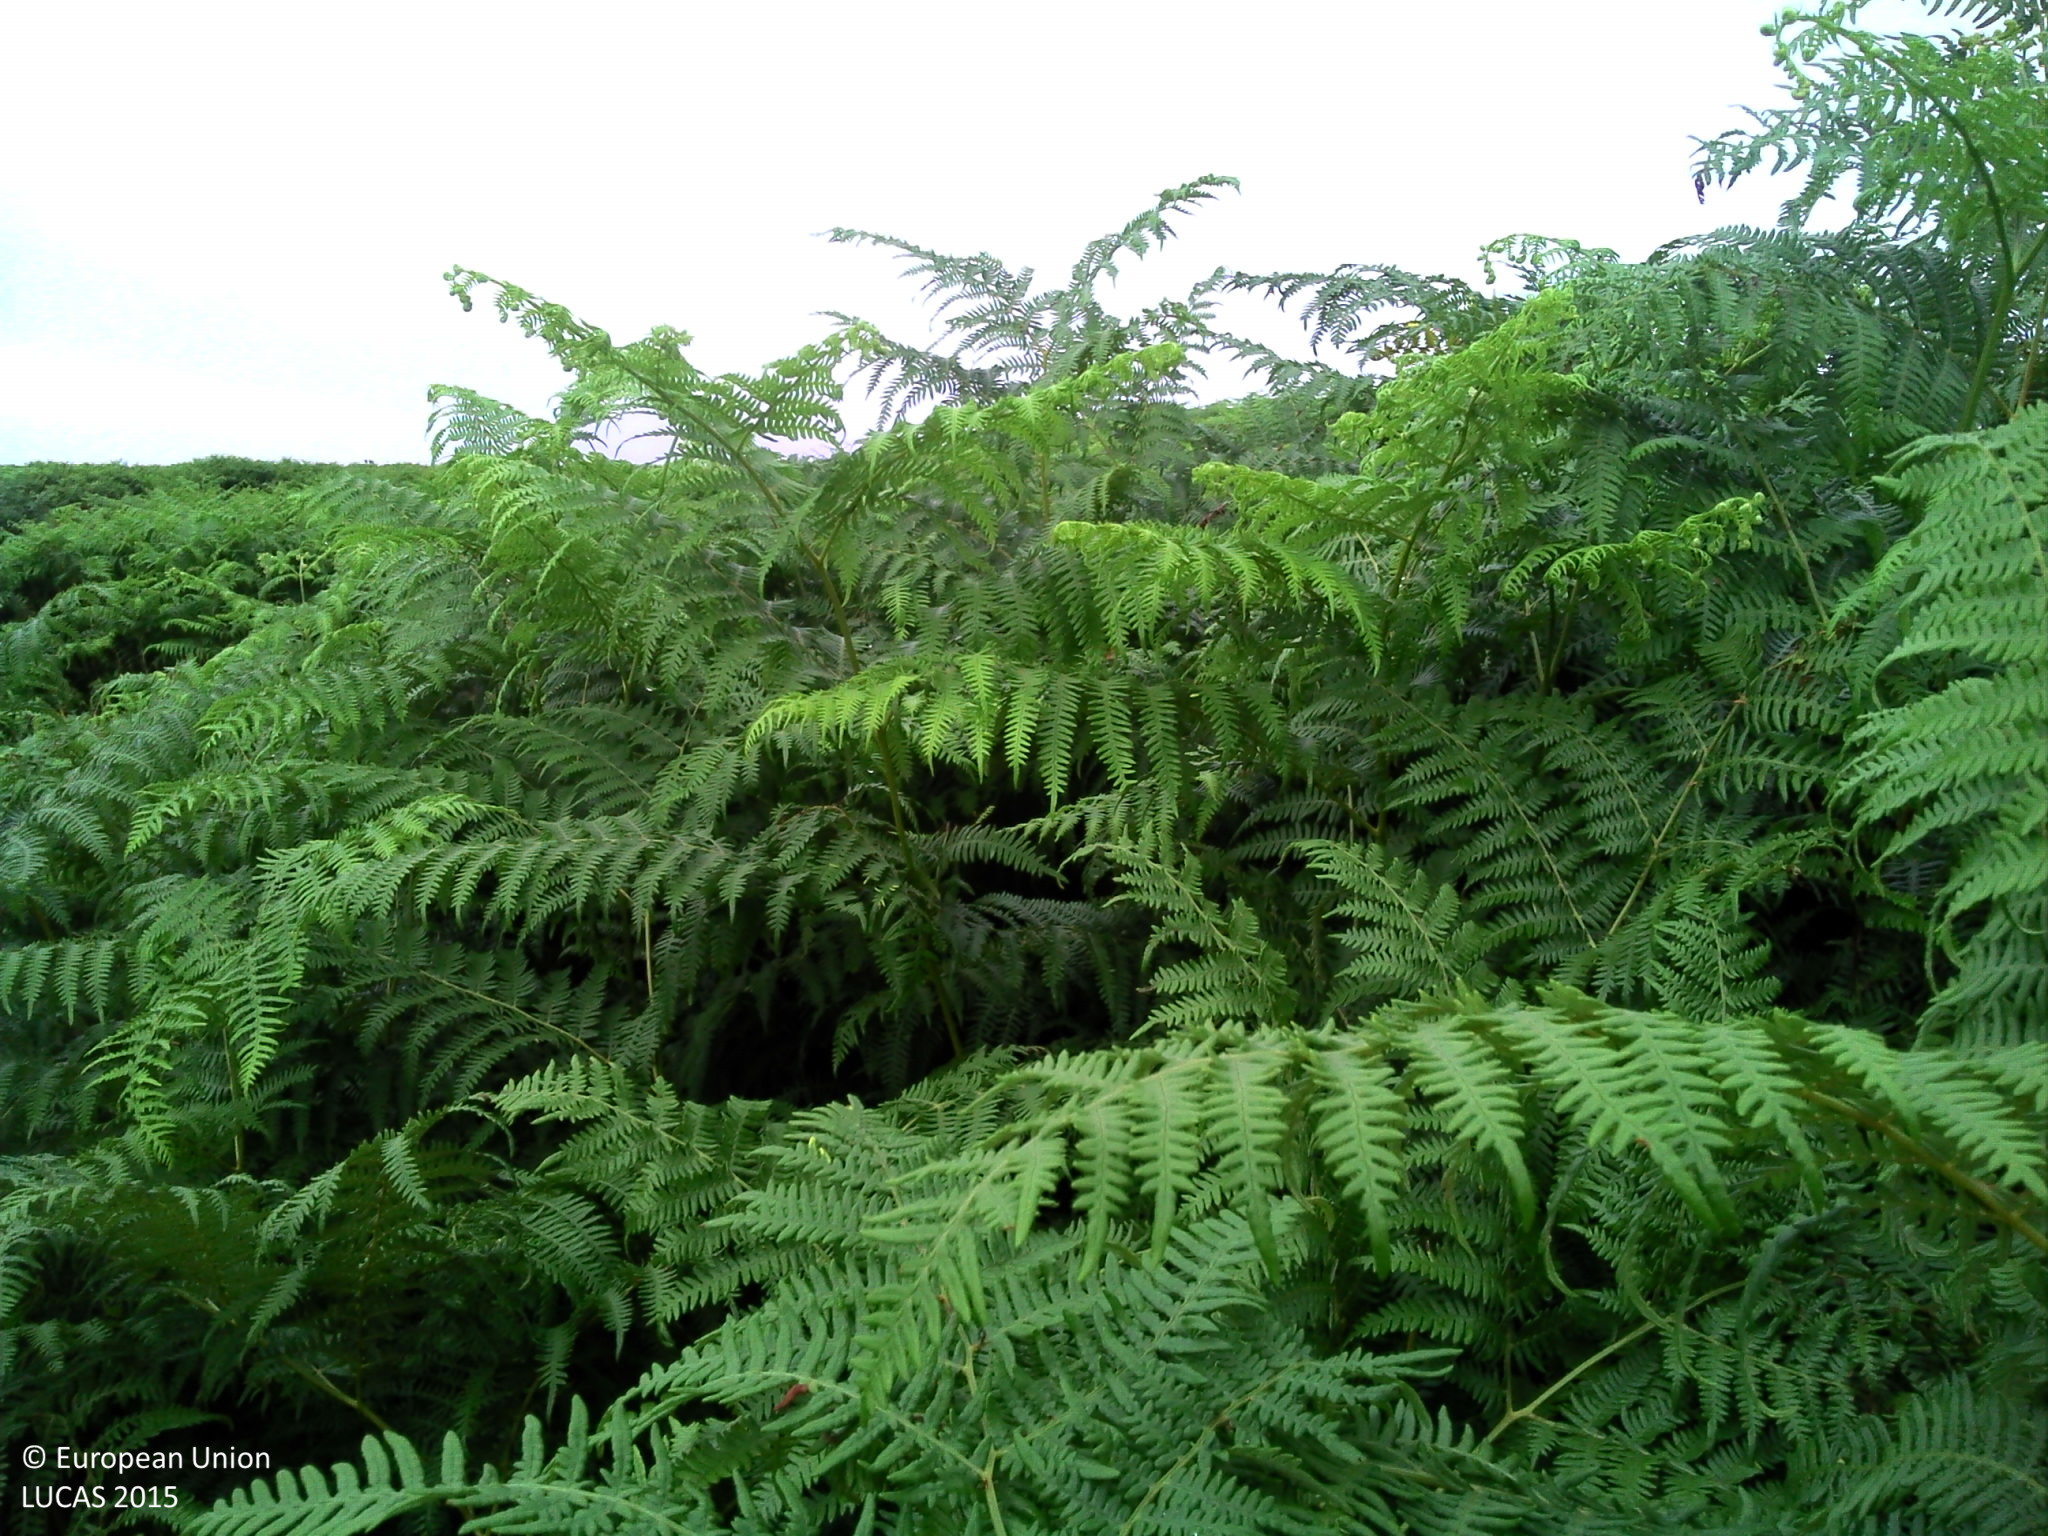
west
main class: Shrubland
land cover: Shrubland without tree cover
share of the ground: > 75 %
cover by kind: shrubs 60 %, herbaceous plants 30 %, consolidated bare surface 10 %
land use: Semi-natural and natural areas not in use
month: July
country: FR
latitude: 47.5052
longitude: -3.1449
